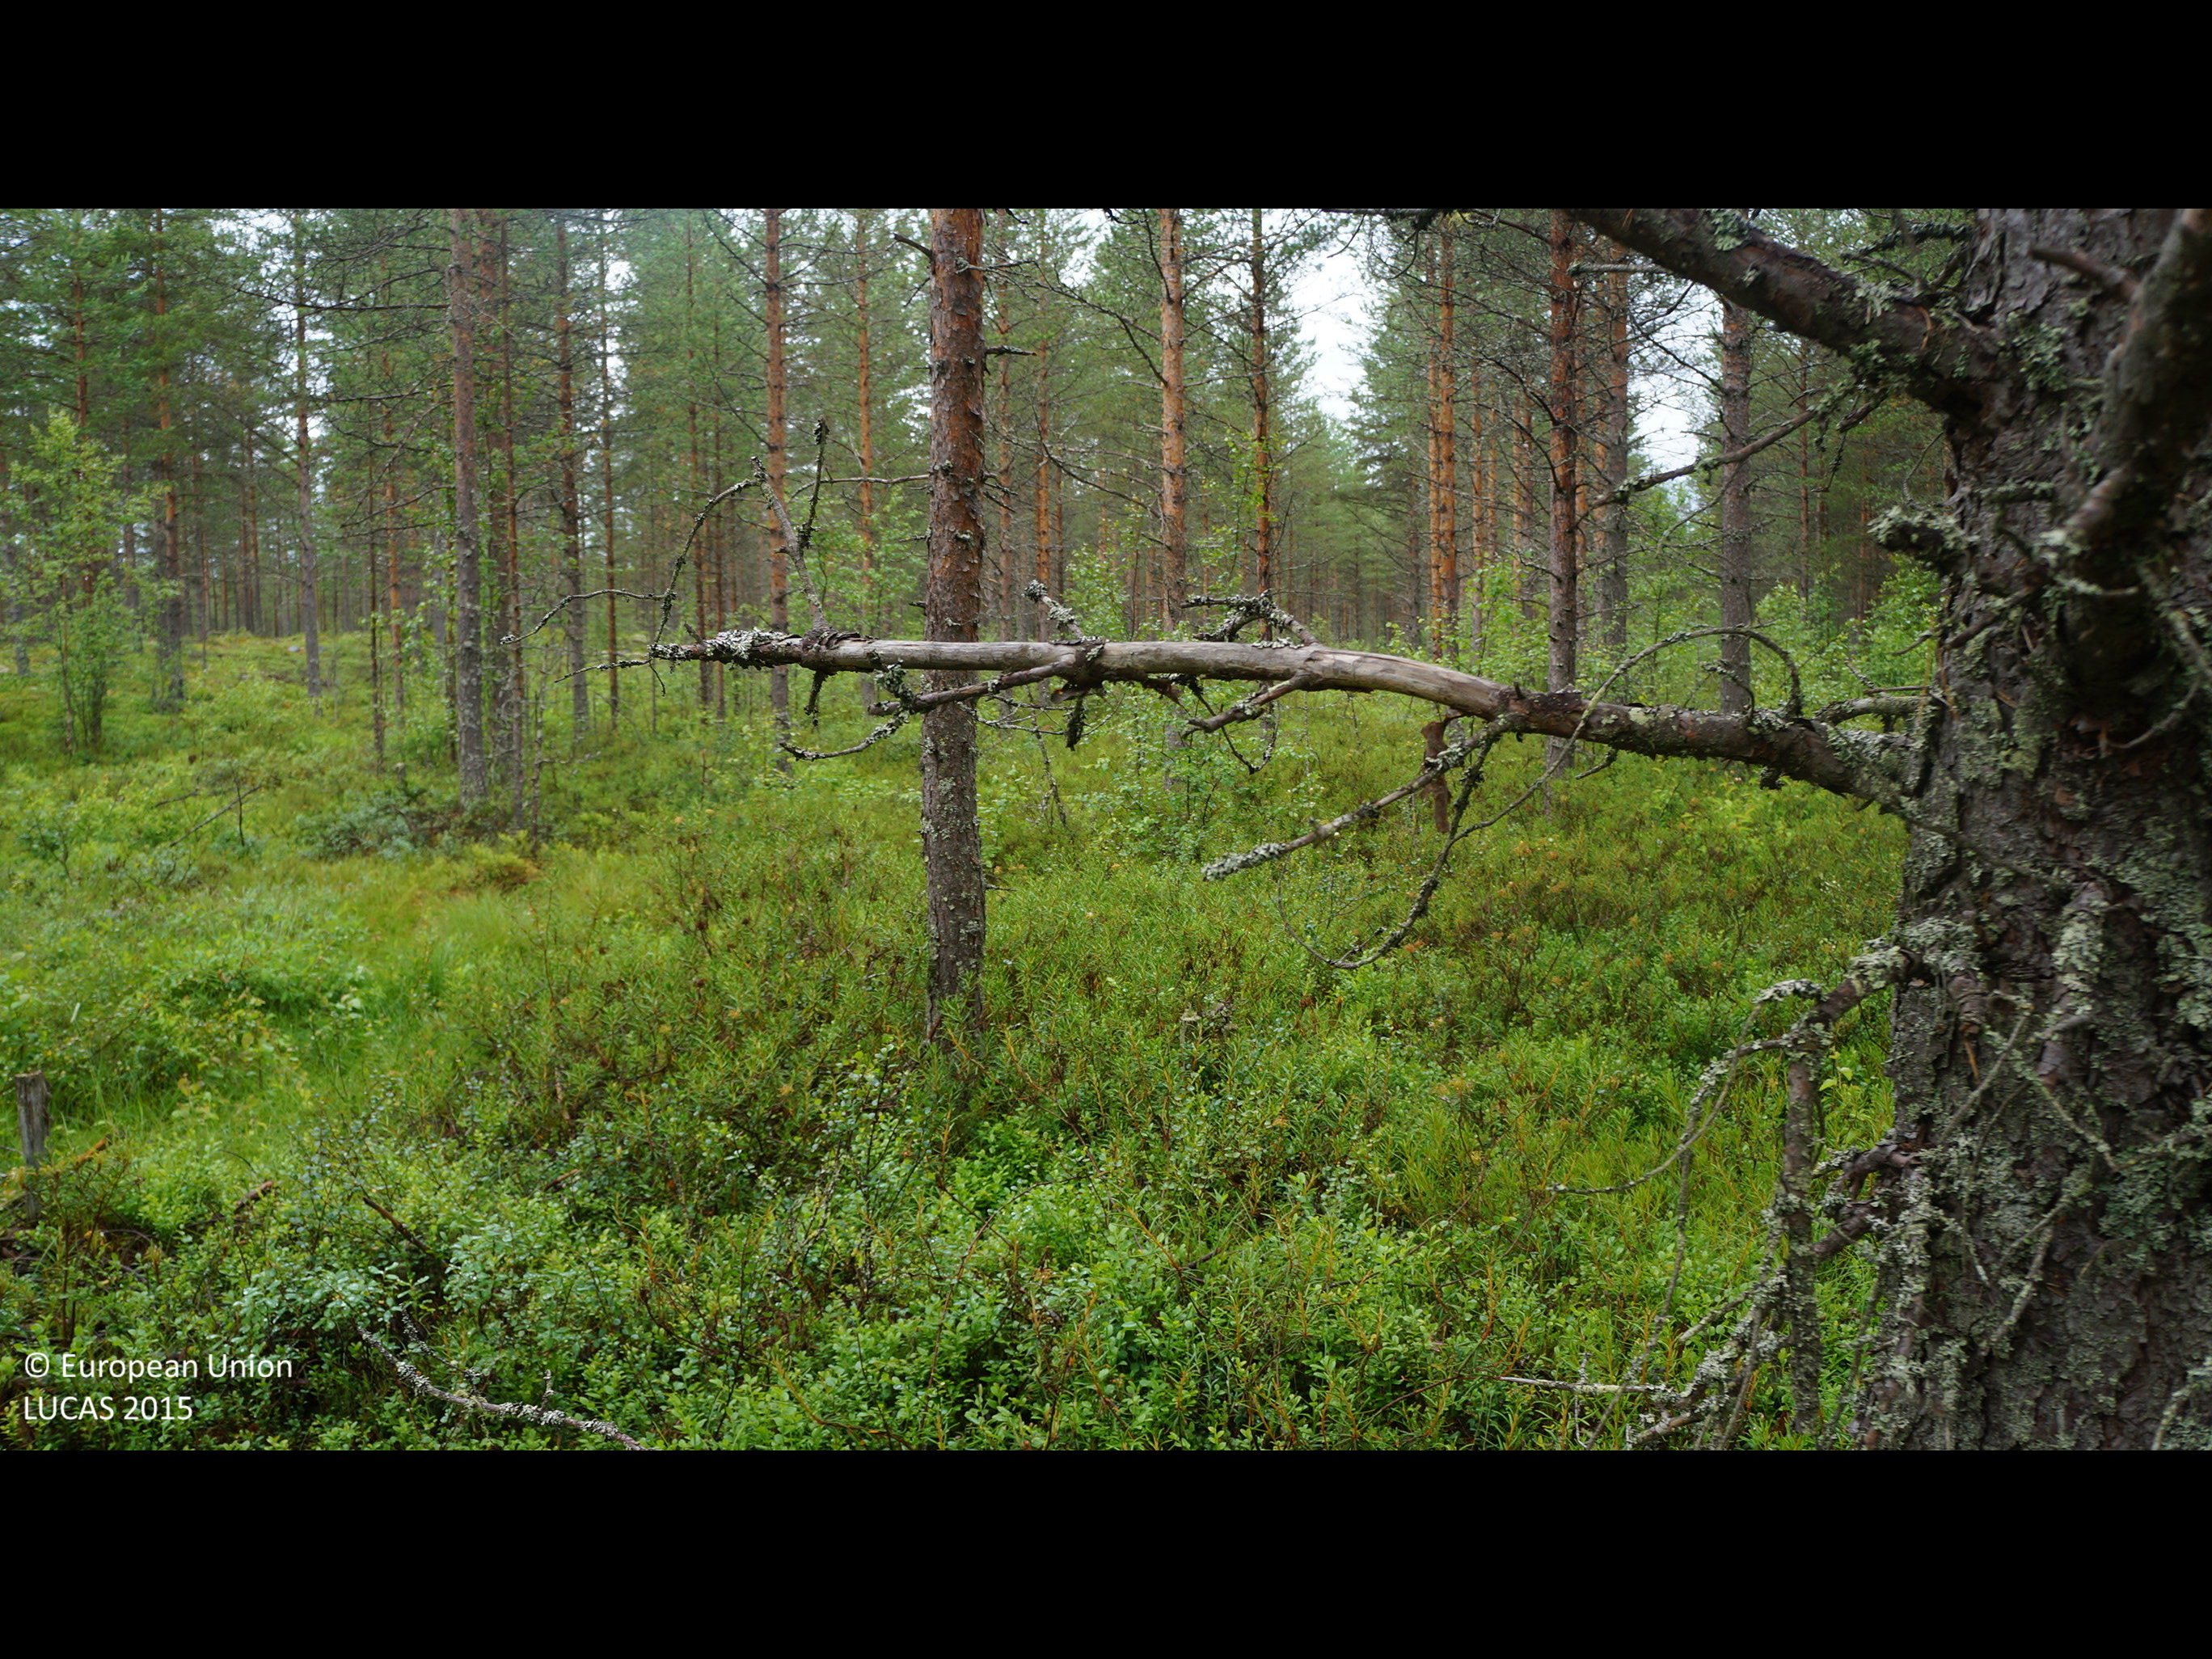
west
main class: Woodland
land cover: Pine dominated coniferous woodland
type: boreal forest
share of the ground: 50 - 75 %
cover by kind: coniferous forest trees 55 %, shrubs 40 %, broadleaved forest trees 5 %
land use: Forestry
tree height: > 5 m
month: July
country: FI
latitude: 64.4767
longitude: 24.5689
